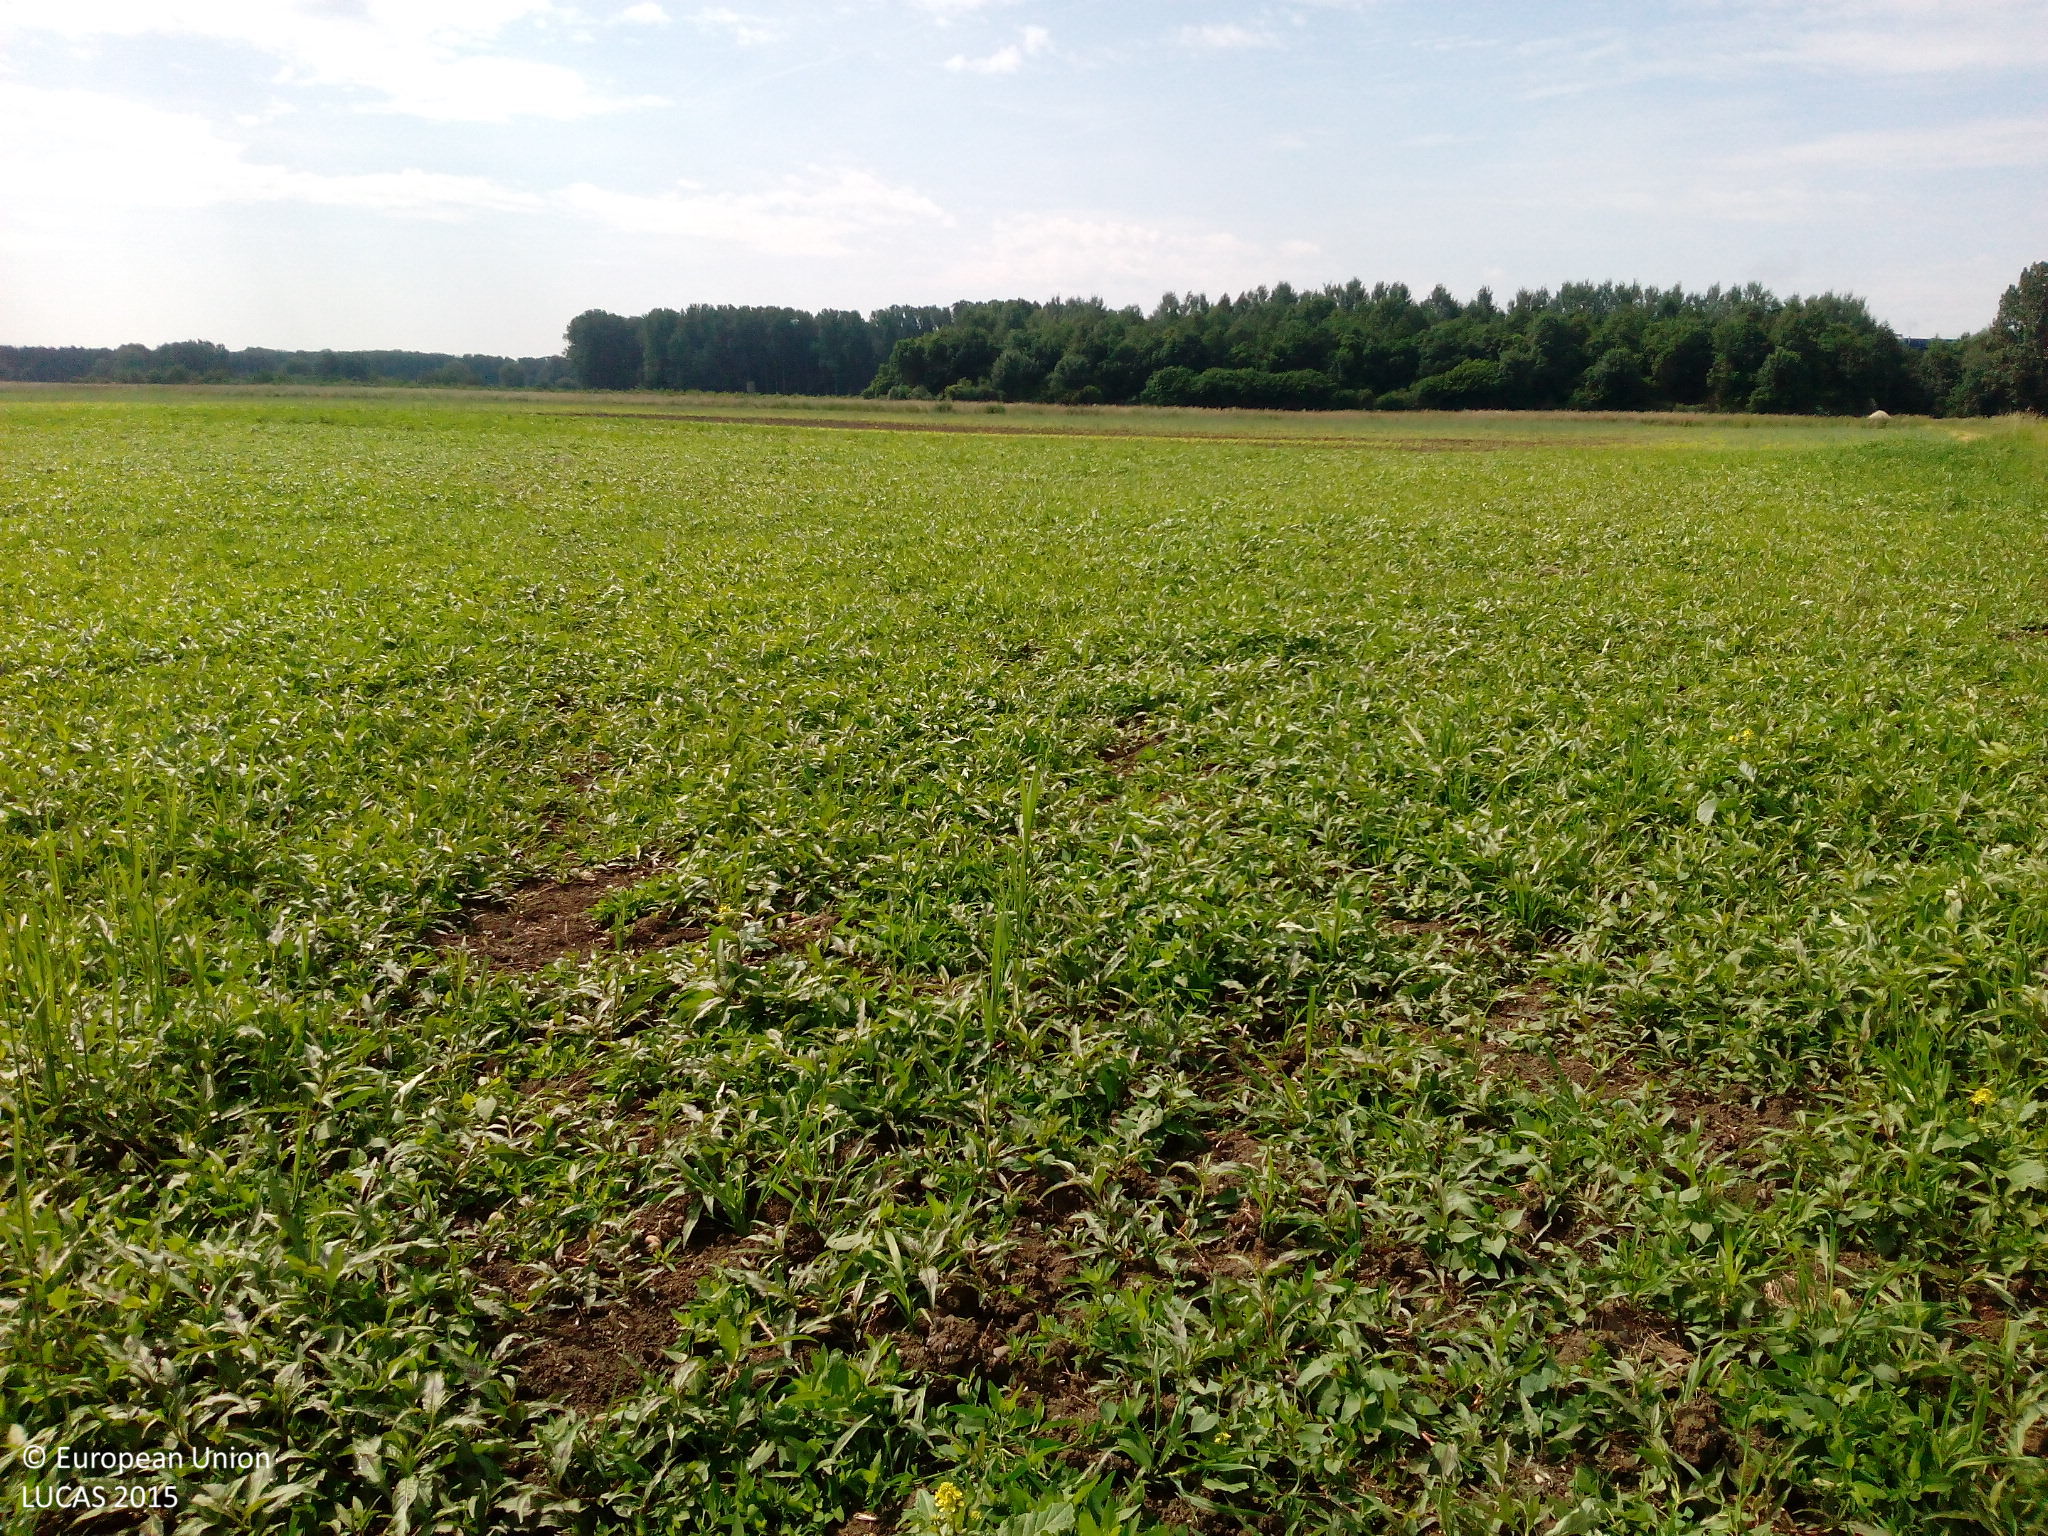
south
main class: Grassland
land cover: Spontaneously vegetated surfaces
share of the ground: 25 - 50 %
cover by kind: unconsolidated bare surface 60 %, herbaceous plants 40 %
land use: Agriculture (excluding fallow land and kitchen gardens)
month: May
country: DE
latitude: 48.6995
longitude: 11.4803
